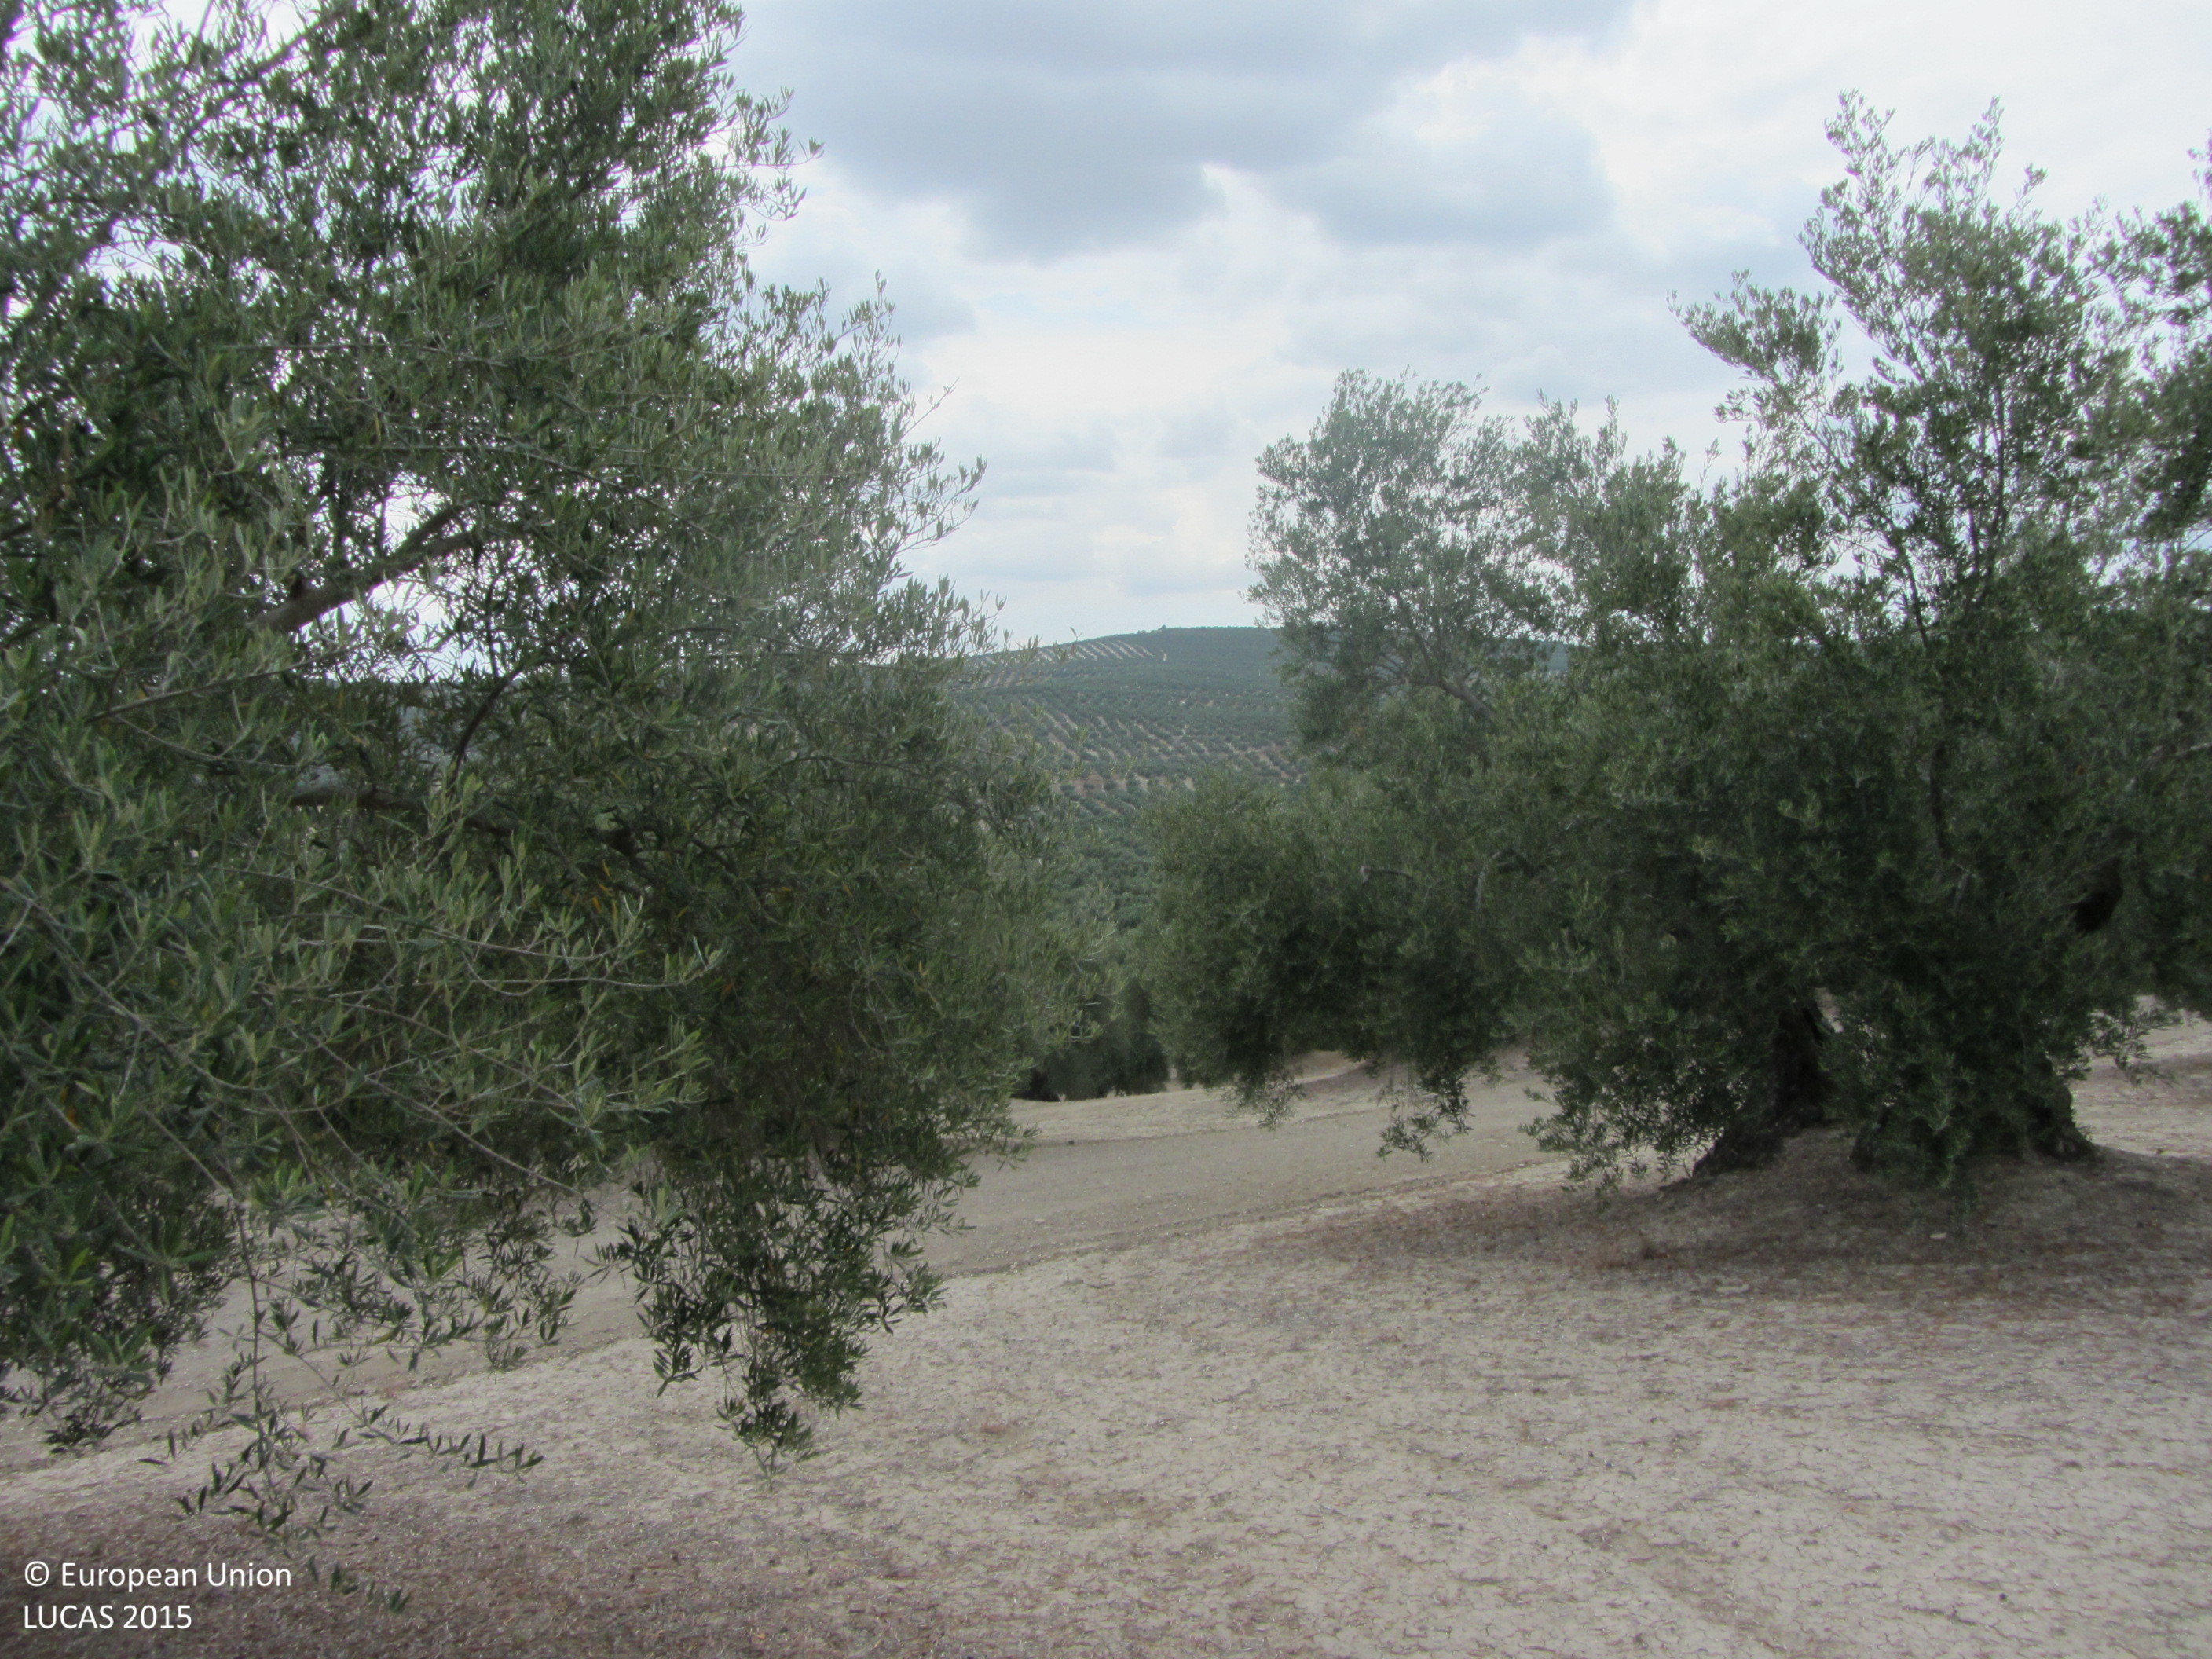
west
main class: Cropland
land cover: Olive groves
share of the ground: 25 - 50 %
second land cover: Other bare soil
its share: > 75 %
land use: Agriculture (excluding fallow land and kitchen gardens)
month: June
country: ES
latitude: 38.0060
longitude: -3.2670
